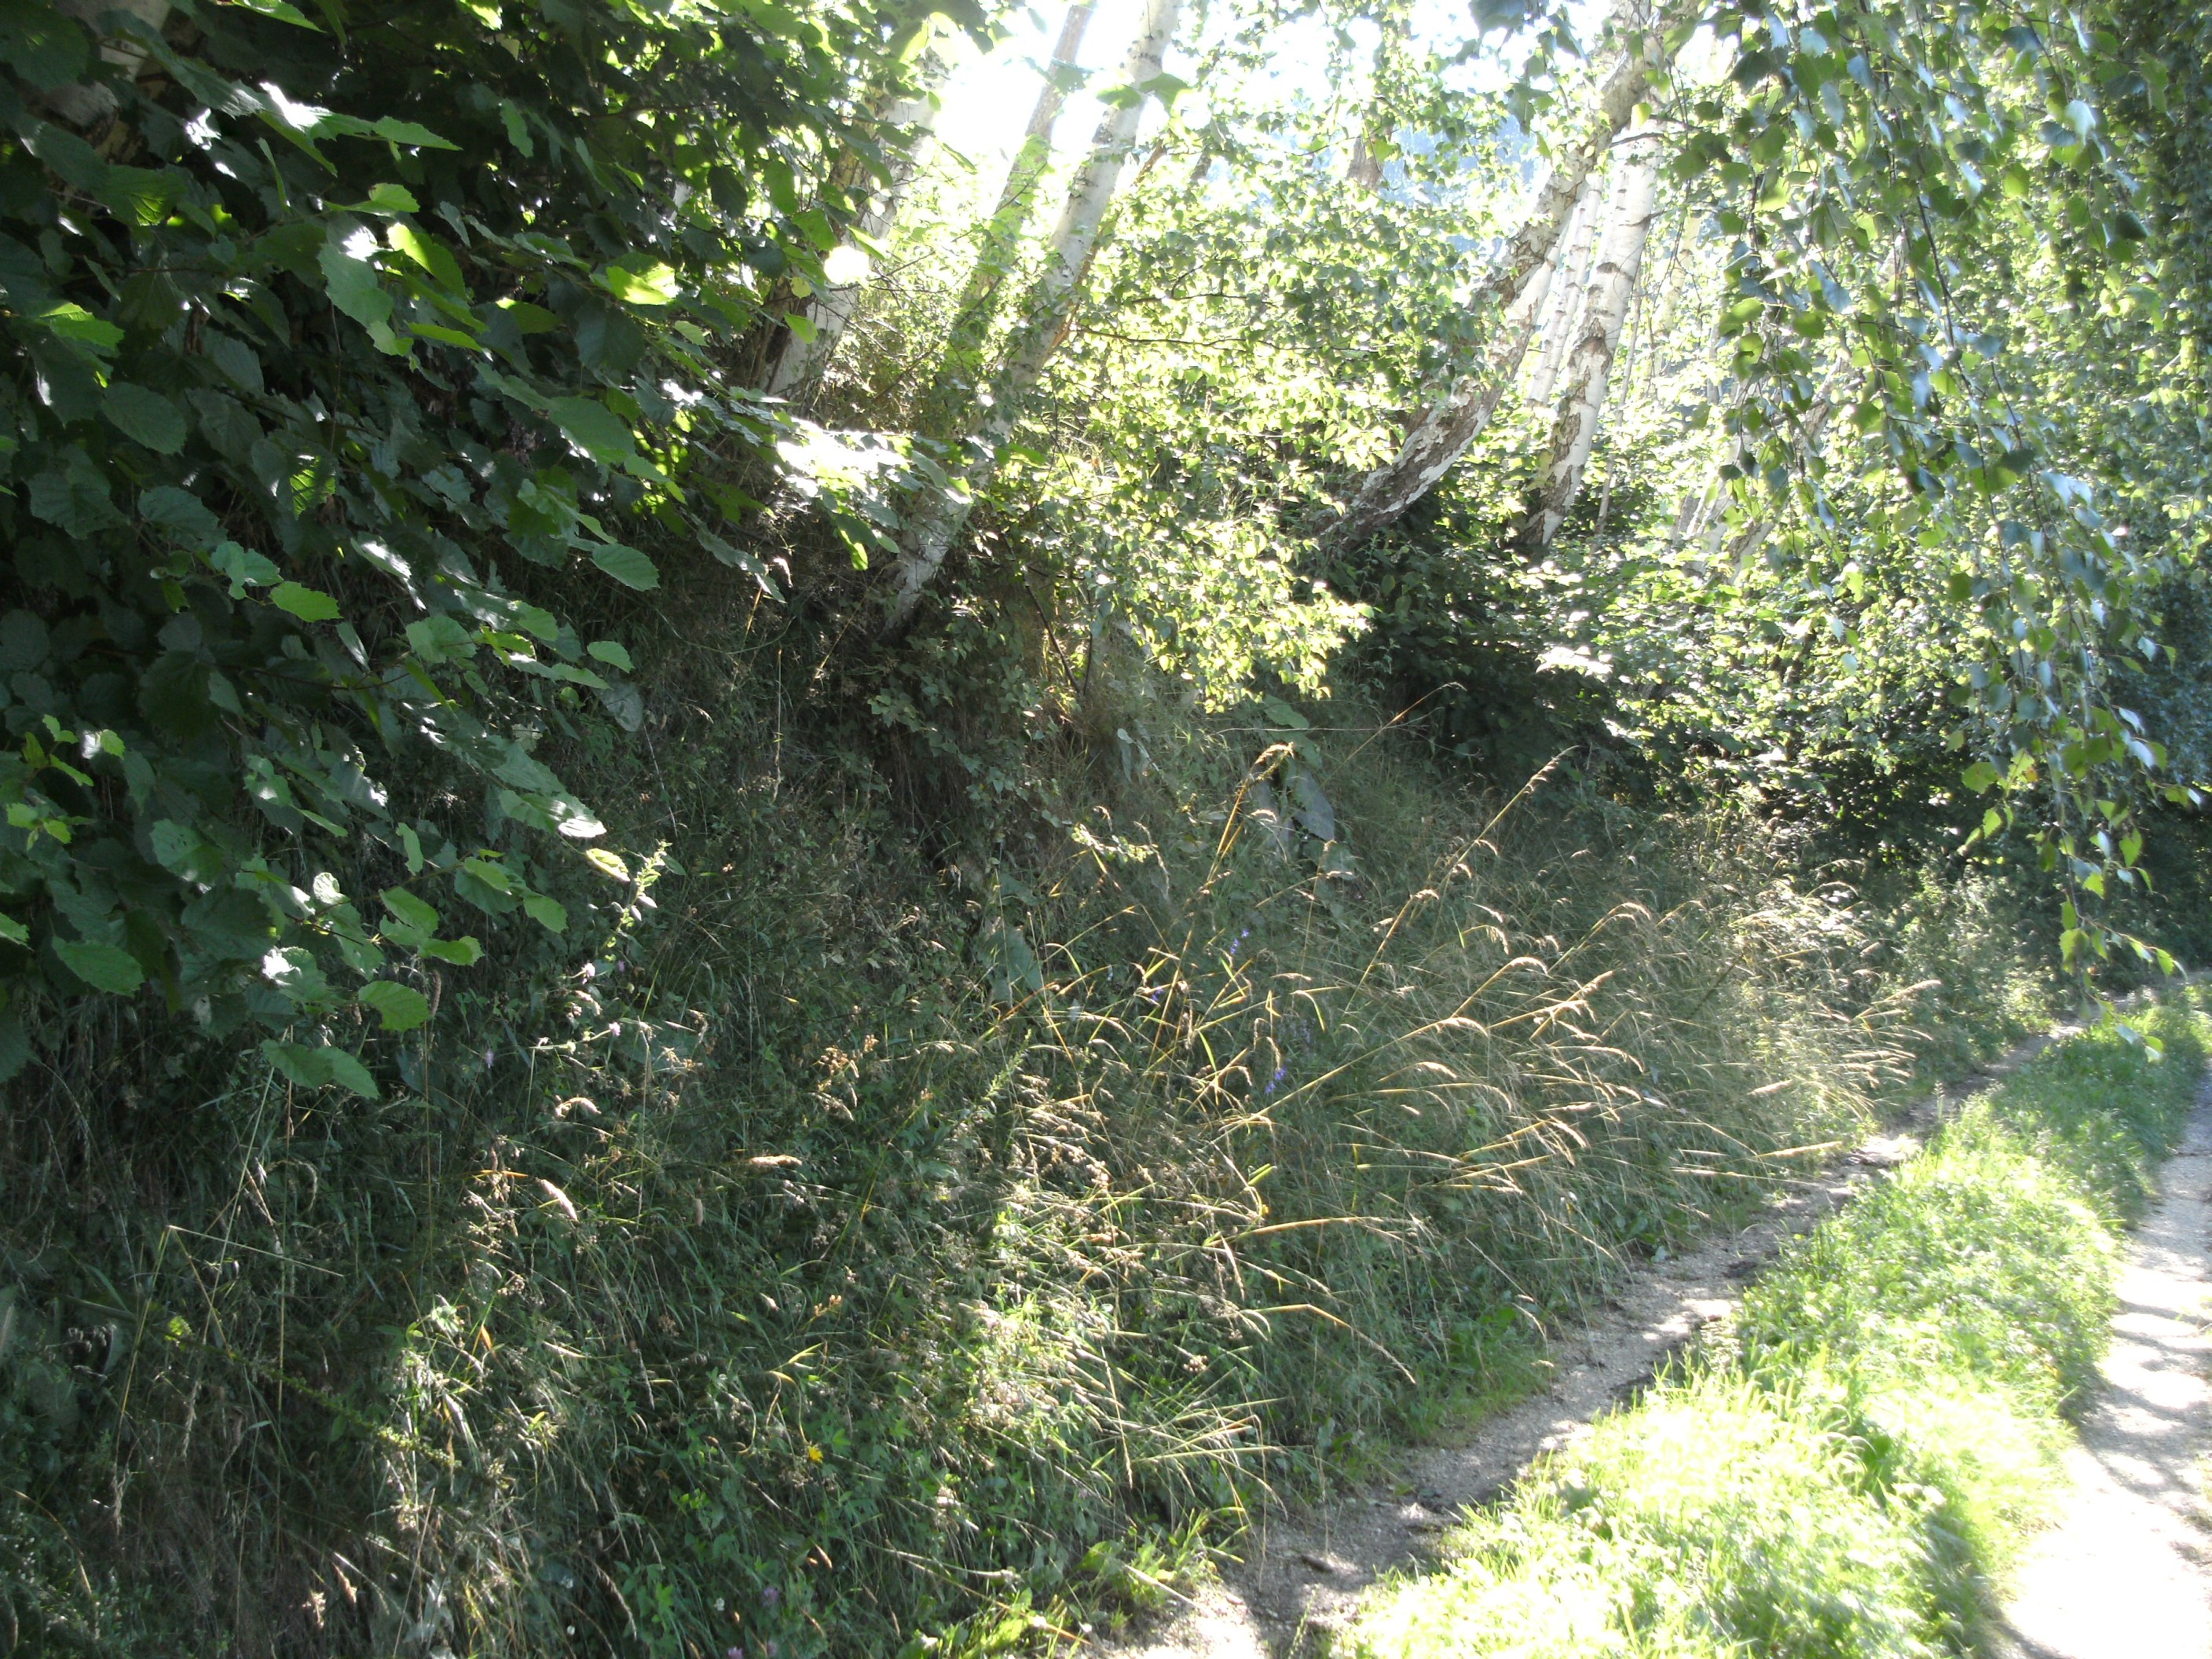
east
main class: Grassland
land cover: Grassland without tree/shrub cover
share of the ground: > 75 %
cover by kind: herbaceous plants 100 %
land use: Agriculture (excluding fallow land and kitchen gardens)
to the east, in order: Grassland without tree/shrub cover; Tracks; Grassland without tree/shrub cover
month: July
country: AT
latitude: 46.8157
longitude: 14.9133
